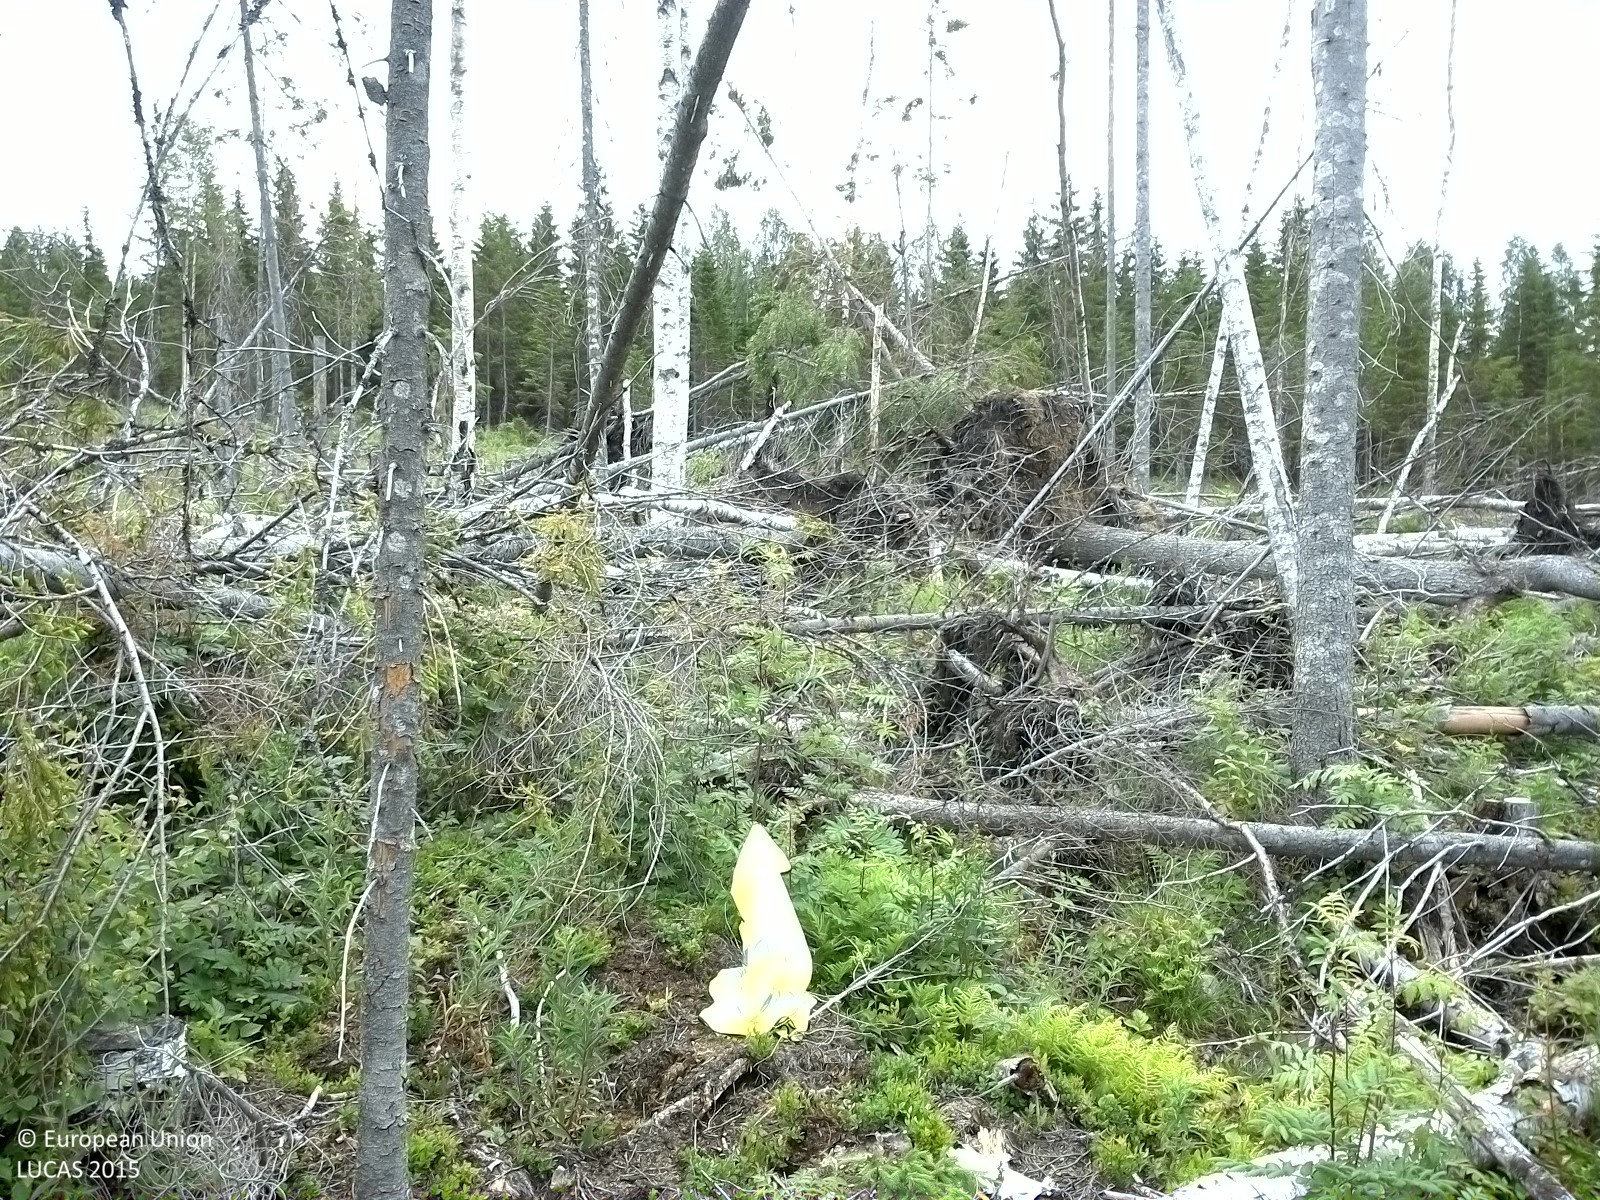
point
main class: Woodland
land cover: Broadleaved woodland
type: boreal forest
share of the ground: 10 - 25 %
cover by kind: shrubs 30 %, herbaceous plants 30 %, broadleaved forest trees 15 %
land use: Forestry
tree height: < 5 m
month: July
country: SE
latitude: 62.0887
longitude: 16.9712
